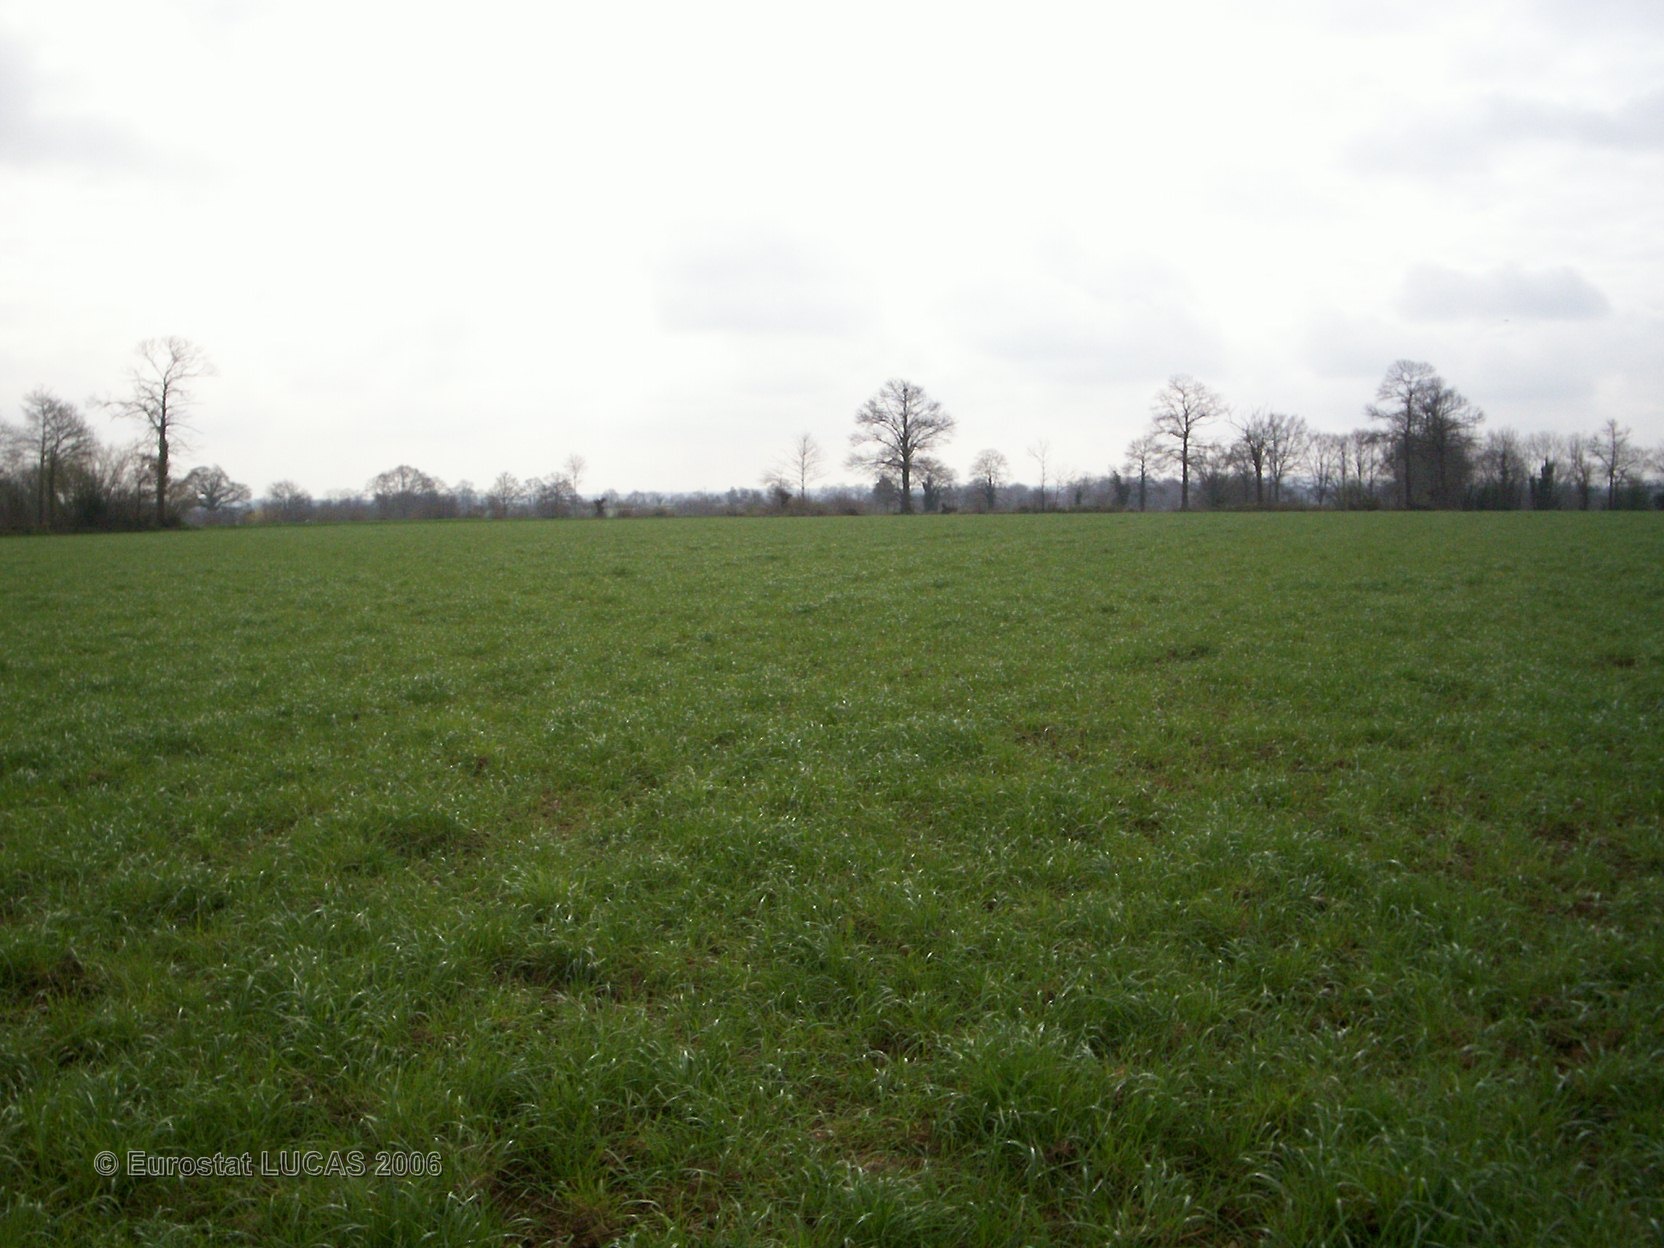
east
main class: Grassland
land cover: Grassland without tree/shrub cover
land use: Agriculture (excluding fallow land and kitchen gardens)
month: April
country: FR
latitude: 48.0924
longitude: -1.1447
